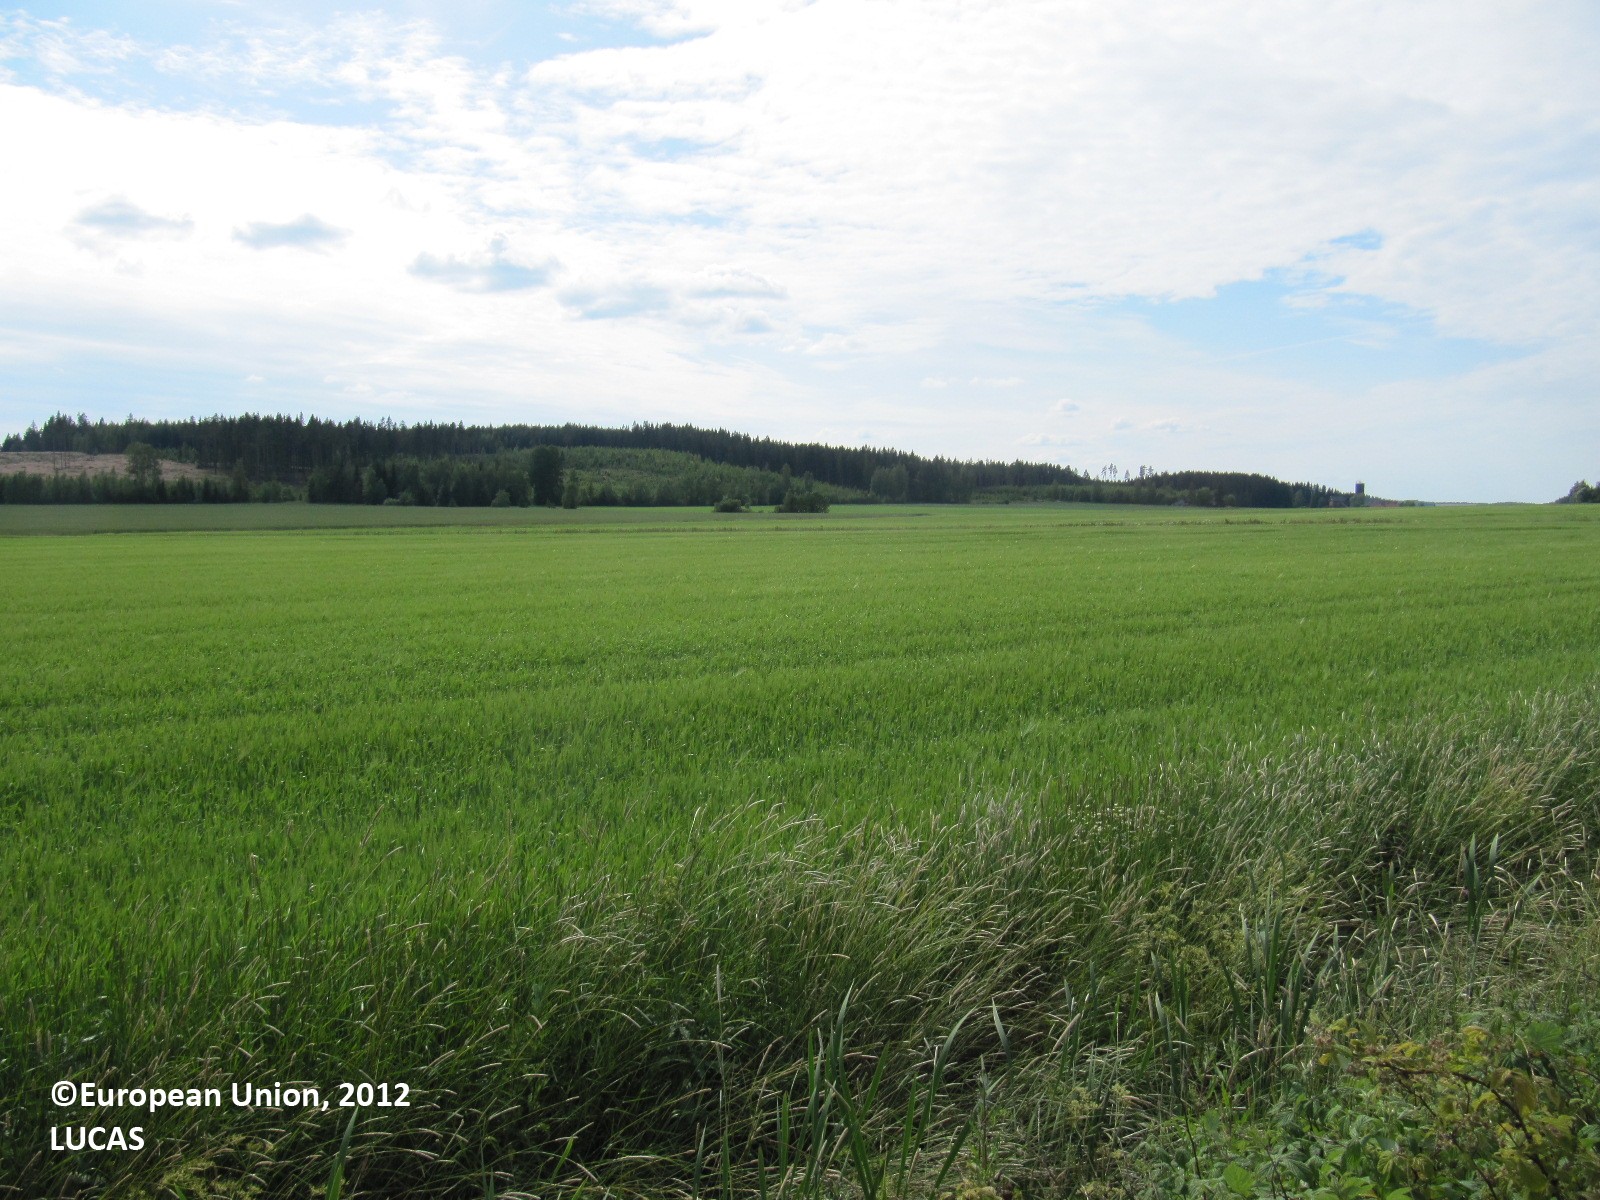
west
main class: Cropland
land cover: Barley
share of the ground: > 75 %
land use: Agriculture (excluding fallow land and kitchen gardens)
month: July
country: FI
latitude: 60.8915
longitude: 23.4057
